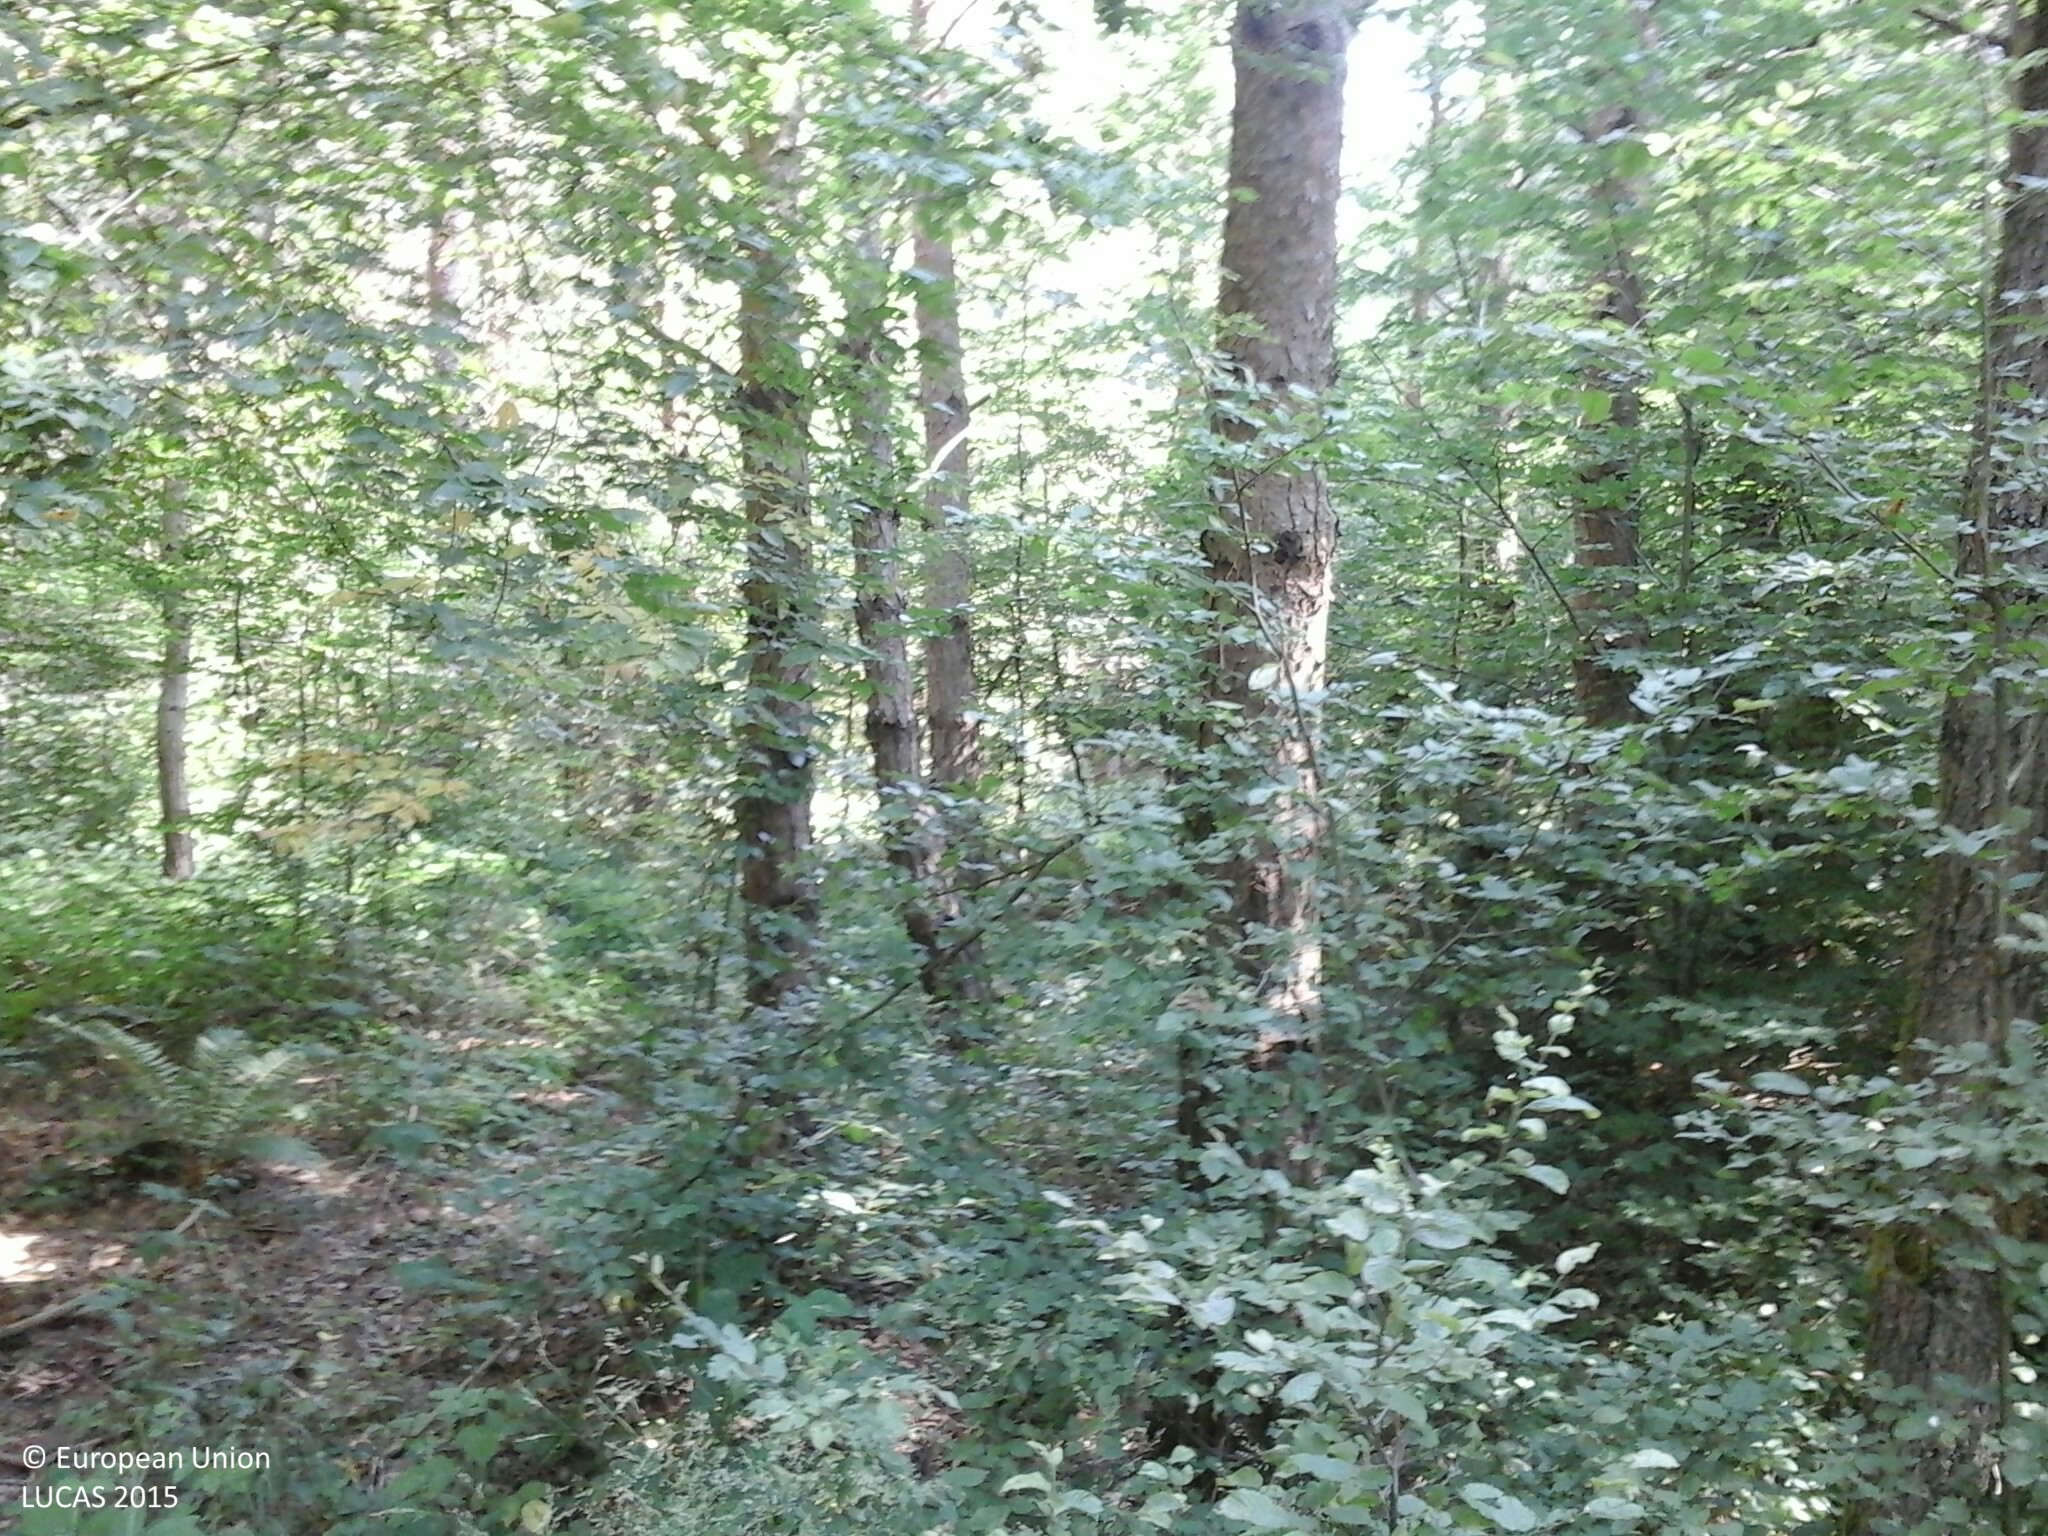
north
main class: Woodland
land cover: Other mixed woodland
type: hemiboreal forest and nemoral coniferous forest and mixed broadleaved-coniferous forest
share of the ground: > 75 %
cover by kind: coniferous forest trees 60 %, broadleaved forest trees 20 %, shrubs 15 %, herbaceous plants 5 %
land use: Forestry
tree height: > 5 m
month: July
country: HU
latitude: 46.9260
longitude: 16.2660
